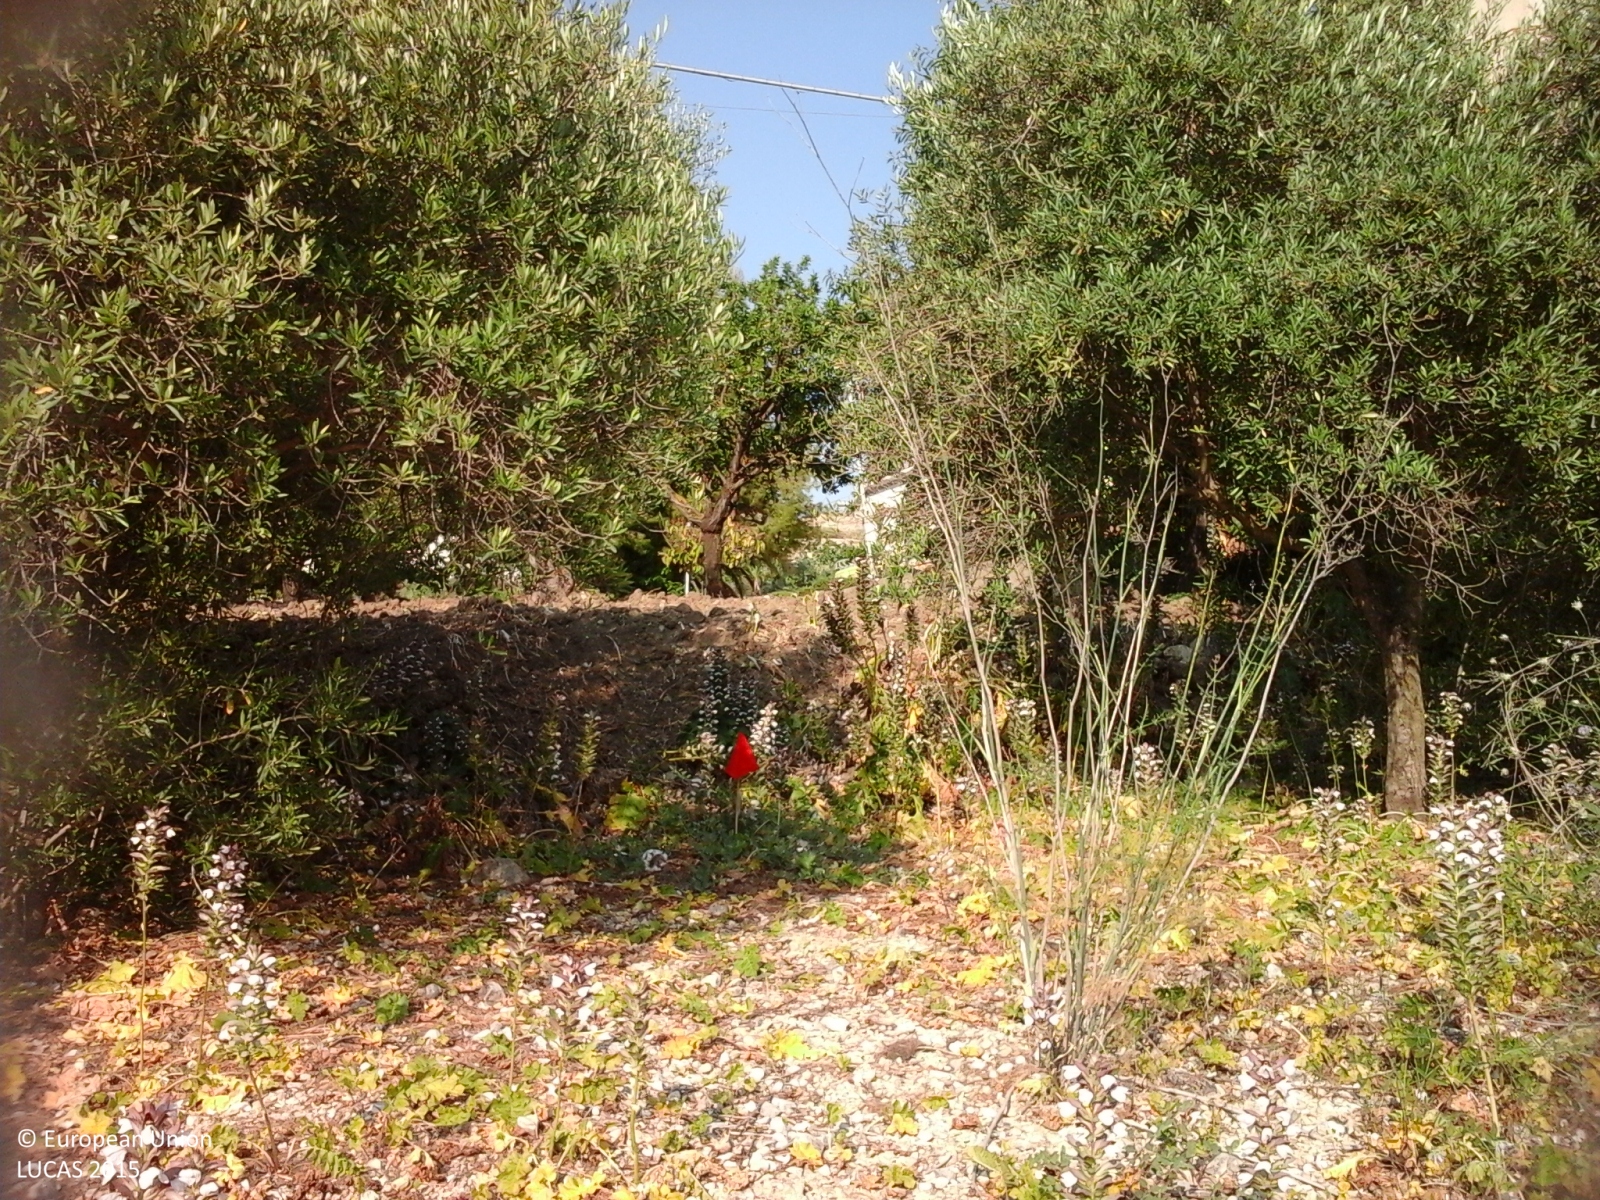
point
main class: Cropland
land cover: Olive groves
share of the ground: 25 - 50 %
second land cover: Spontaneously vegetated surfaces
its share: > 75 %
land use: Agriculture (excluding fallow land and kitchen gardens)
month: June
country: IT
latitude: 37.3912
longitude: 13.5307
